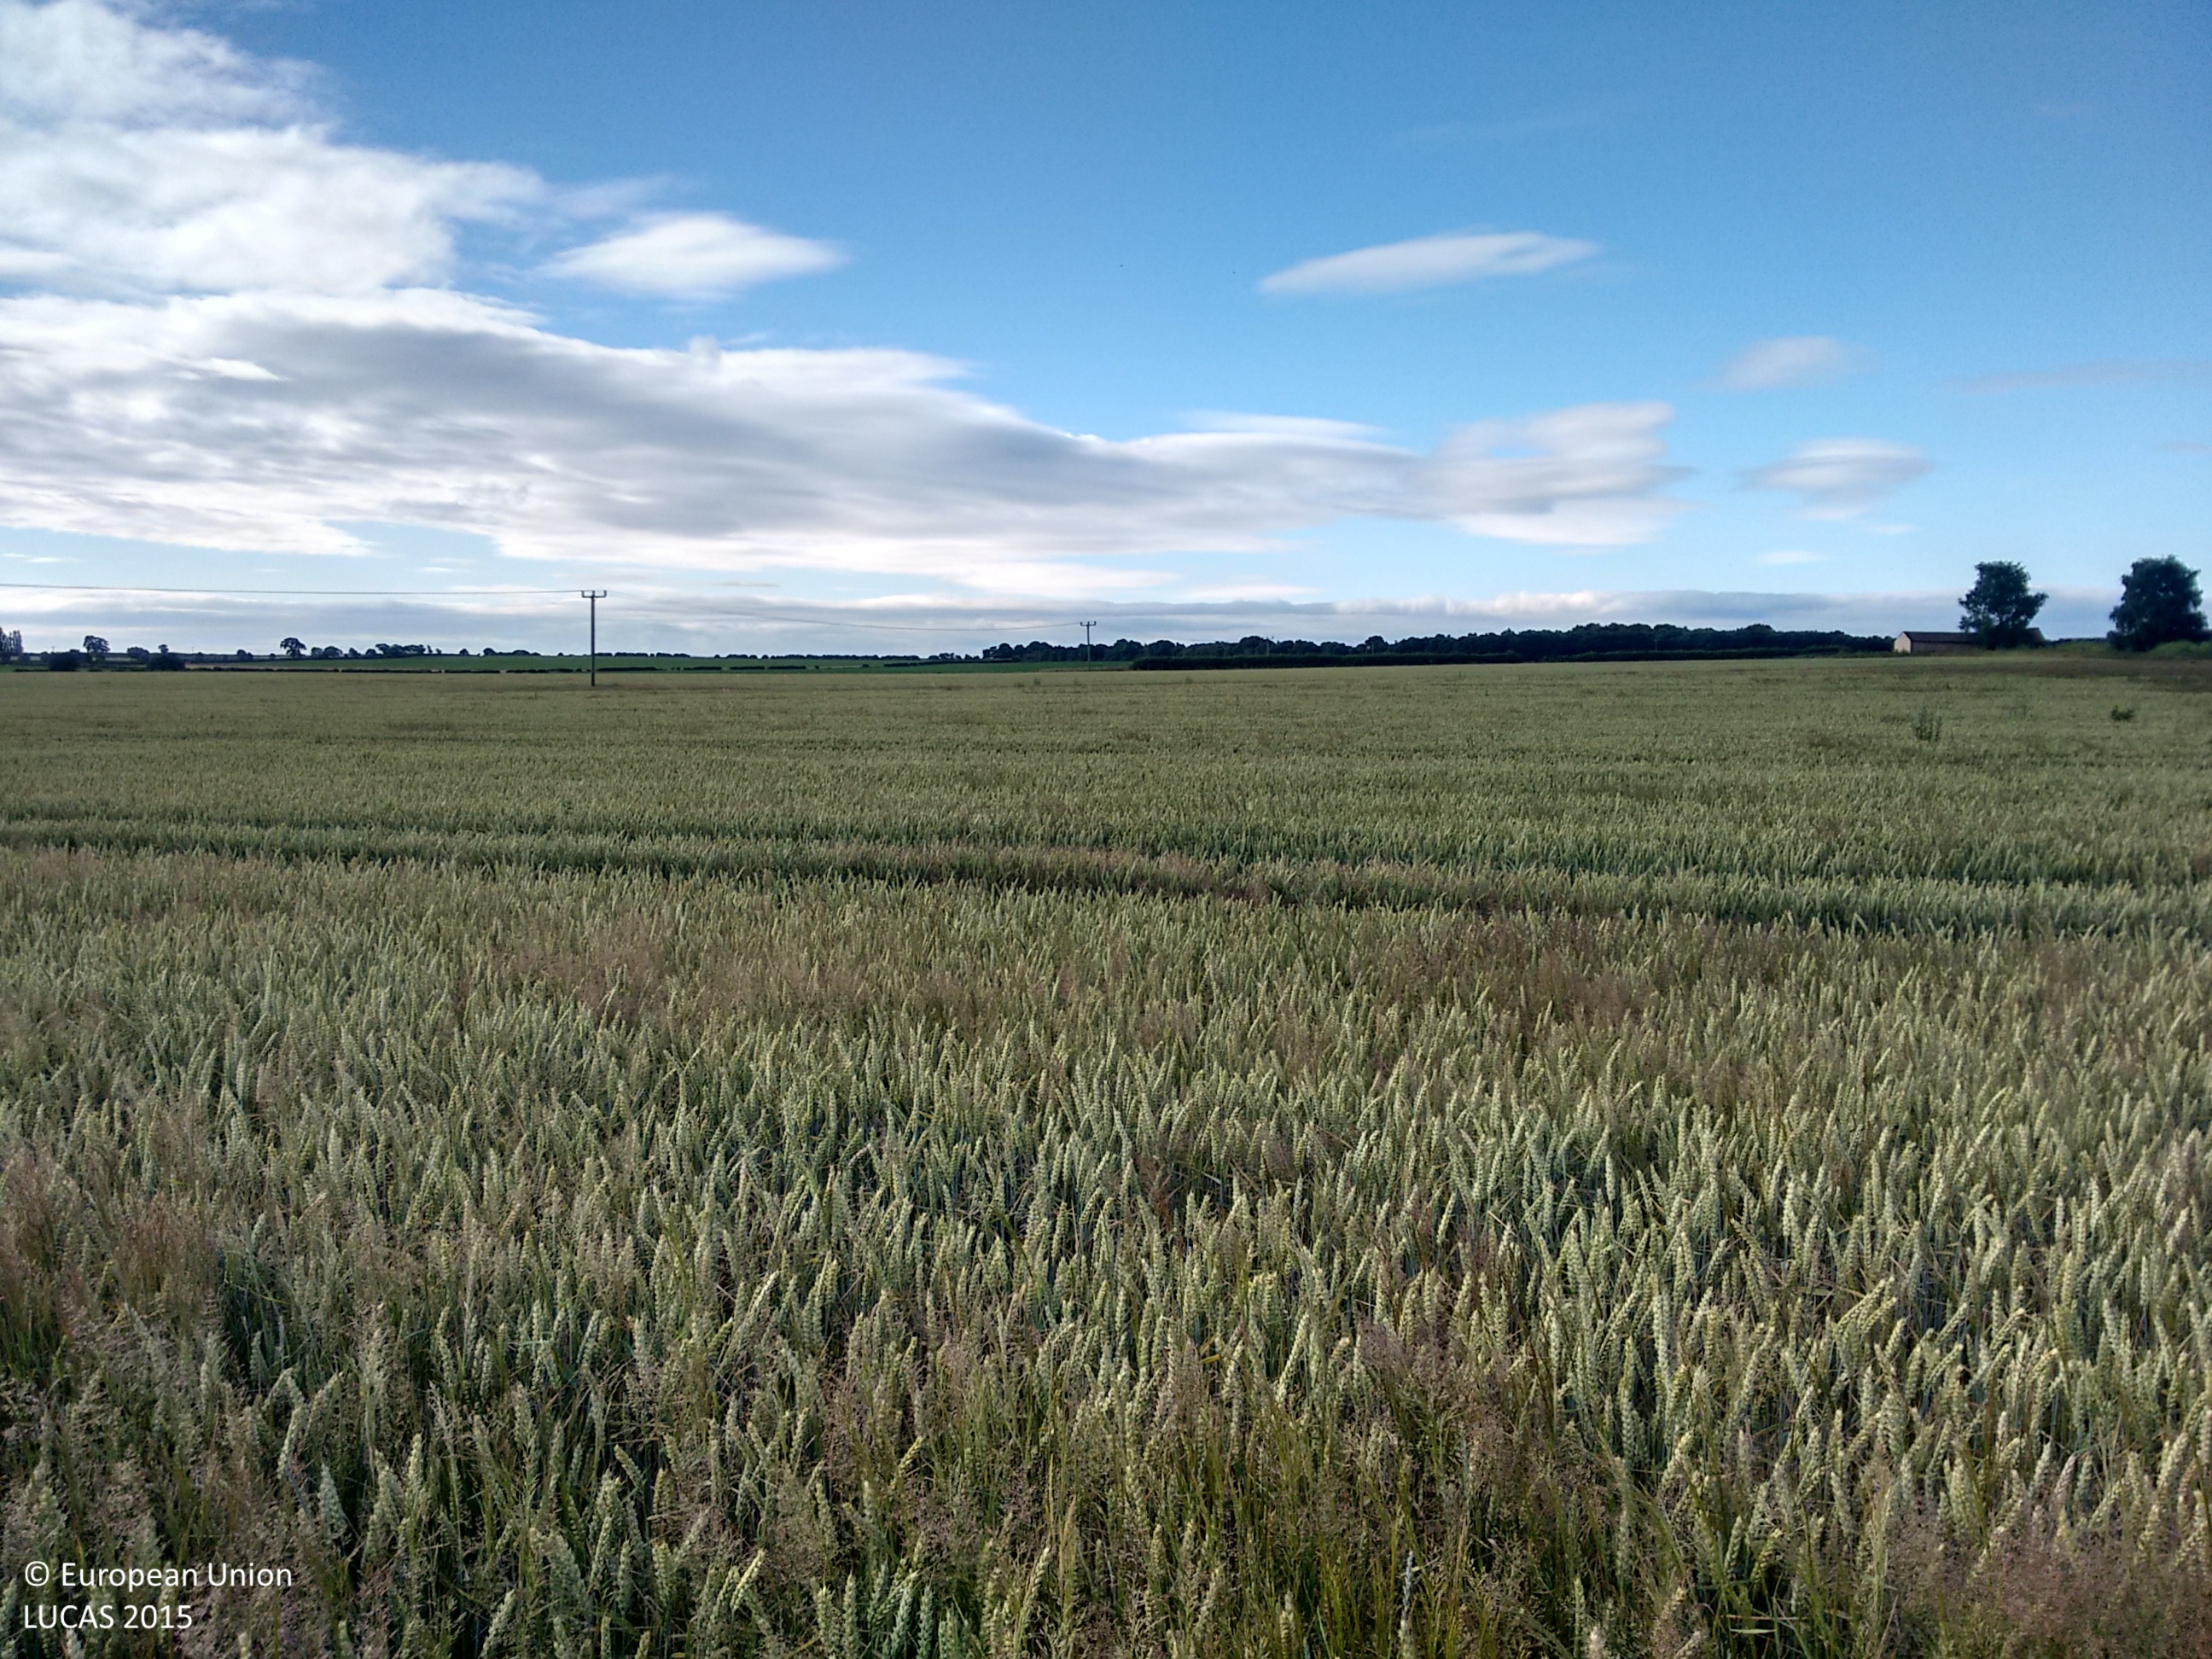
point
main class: Cropland
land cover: Common wheat
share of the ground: > 75 %
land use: Agriculture (excluding fallow land and kitchen gardens)
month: July
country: GB
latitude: 53.3915
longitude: -0.9751
